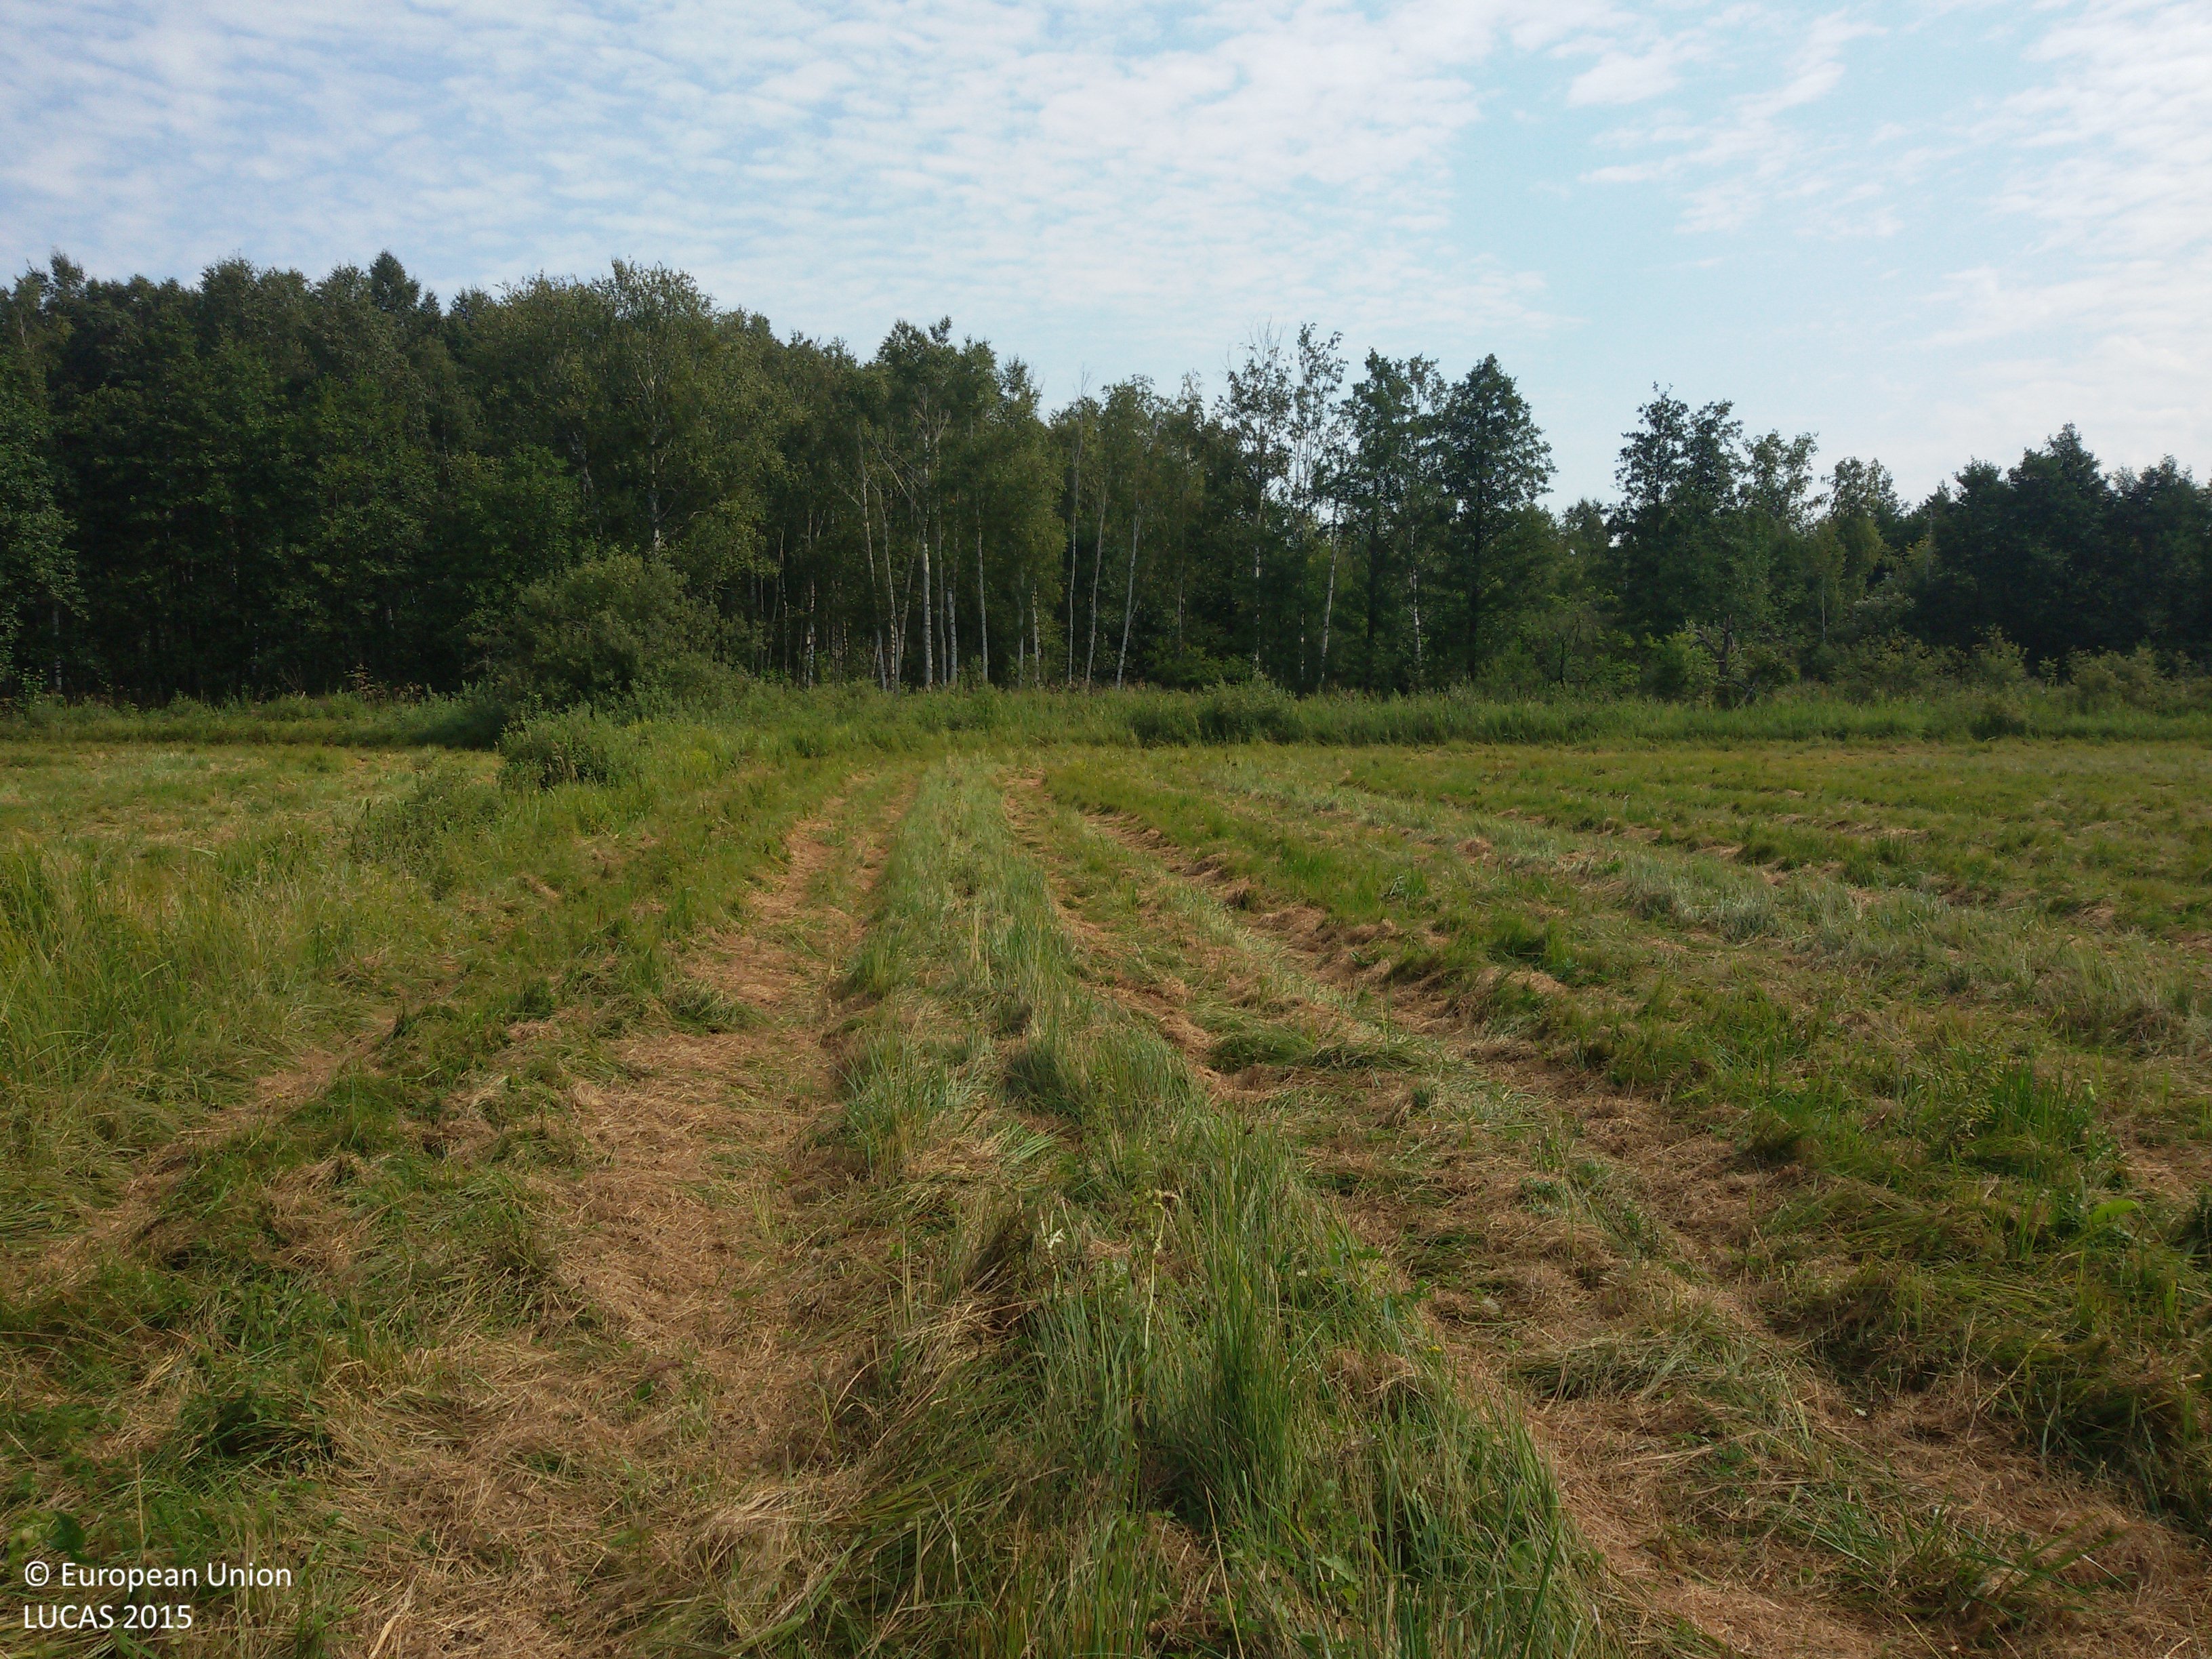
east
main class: Grassland
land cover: Grassland without tree/shrub cover
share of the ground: > 75 %
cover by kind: herbaceous plants 100 %
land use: Agriculture (excluding fallow land and kitchen gardens)
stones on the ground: < 10 %
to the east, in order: Grassland without tree/shrub cover; Grassland with sparse tree/shrub cover; Broadleaved woodland
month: August
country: PL
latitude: 53.7611
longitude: 21.1025
